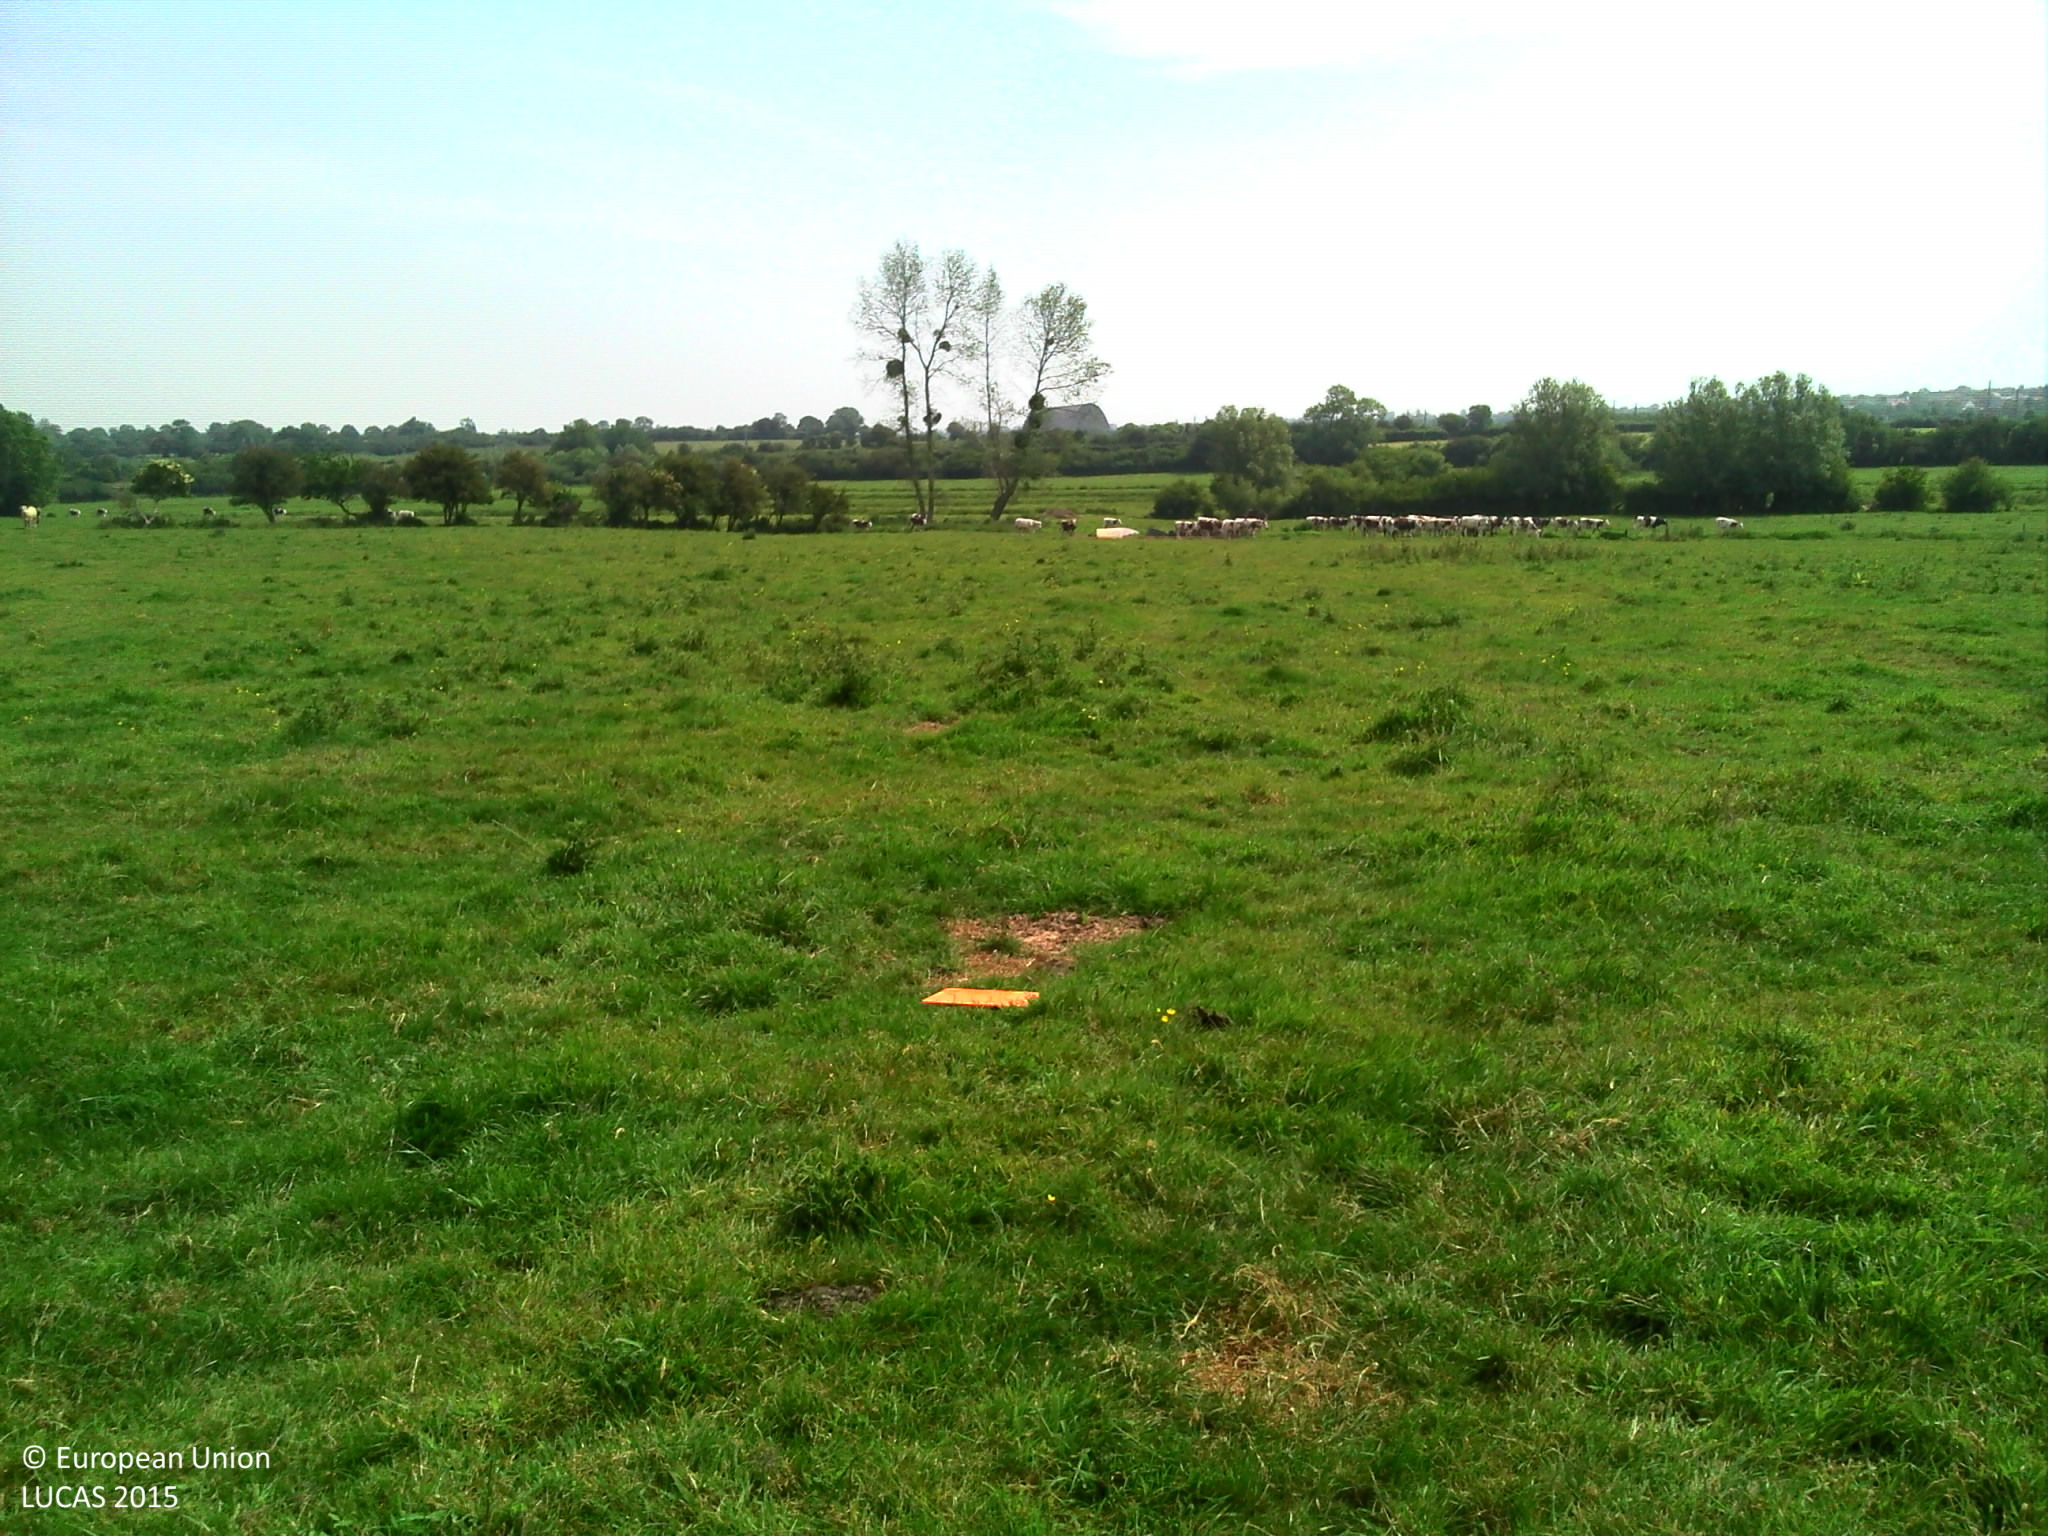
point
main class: Grassland
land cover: Grassland without tree/shrub cover
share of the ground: > 75 %
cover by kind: herbaceous plants 100 %
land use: Agriculture (excluding fallow land and kitchen gardens)
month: June
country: FR
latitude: 49.4469
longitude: -1.3996
